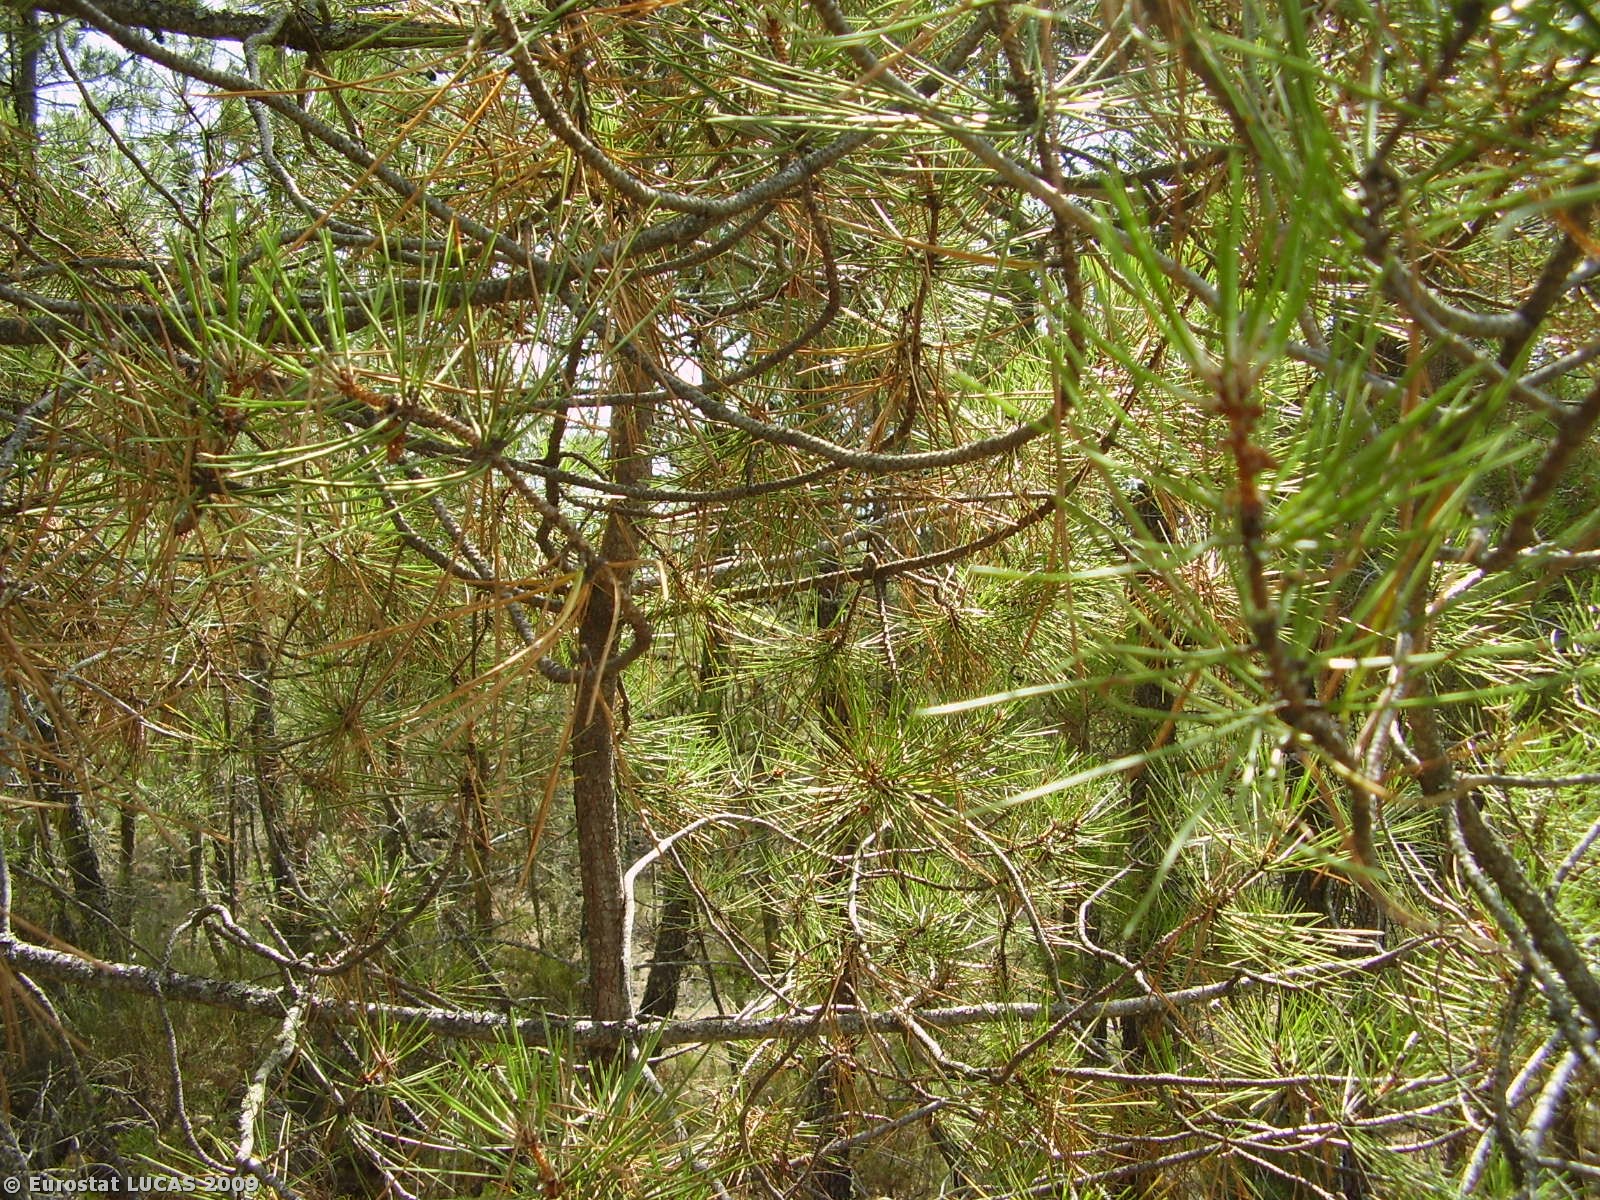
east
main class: Woodland
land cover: Coniferous woodland
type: coniferous forest of the mediterranean region
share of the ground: 10 - 25 %
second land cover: Shrubland with sparse tree cover
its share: < 10 %
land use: Forestry
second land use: Unused
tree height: > 5 m
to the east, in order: Coniferous woodland; Shrubland with sparse tree cover; Coniferous woodland; Spontaneously vegetated surfaces; Coniferous woodland; Tracks; Coniferous woodland
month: July
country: PT
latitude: 41.3666
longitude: -7.5447
